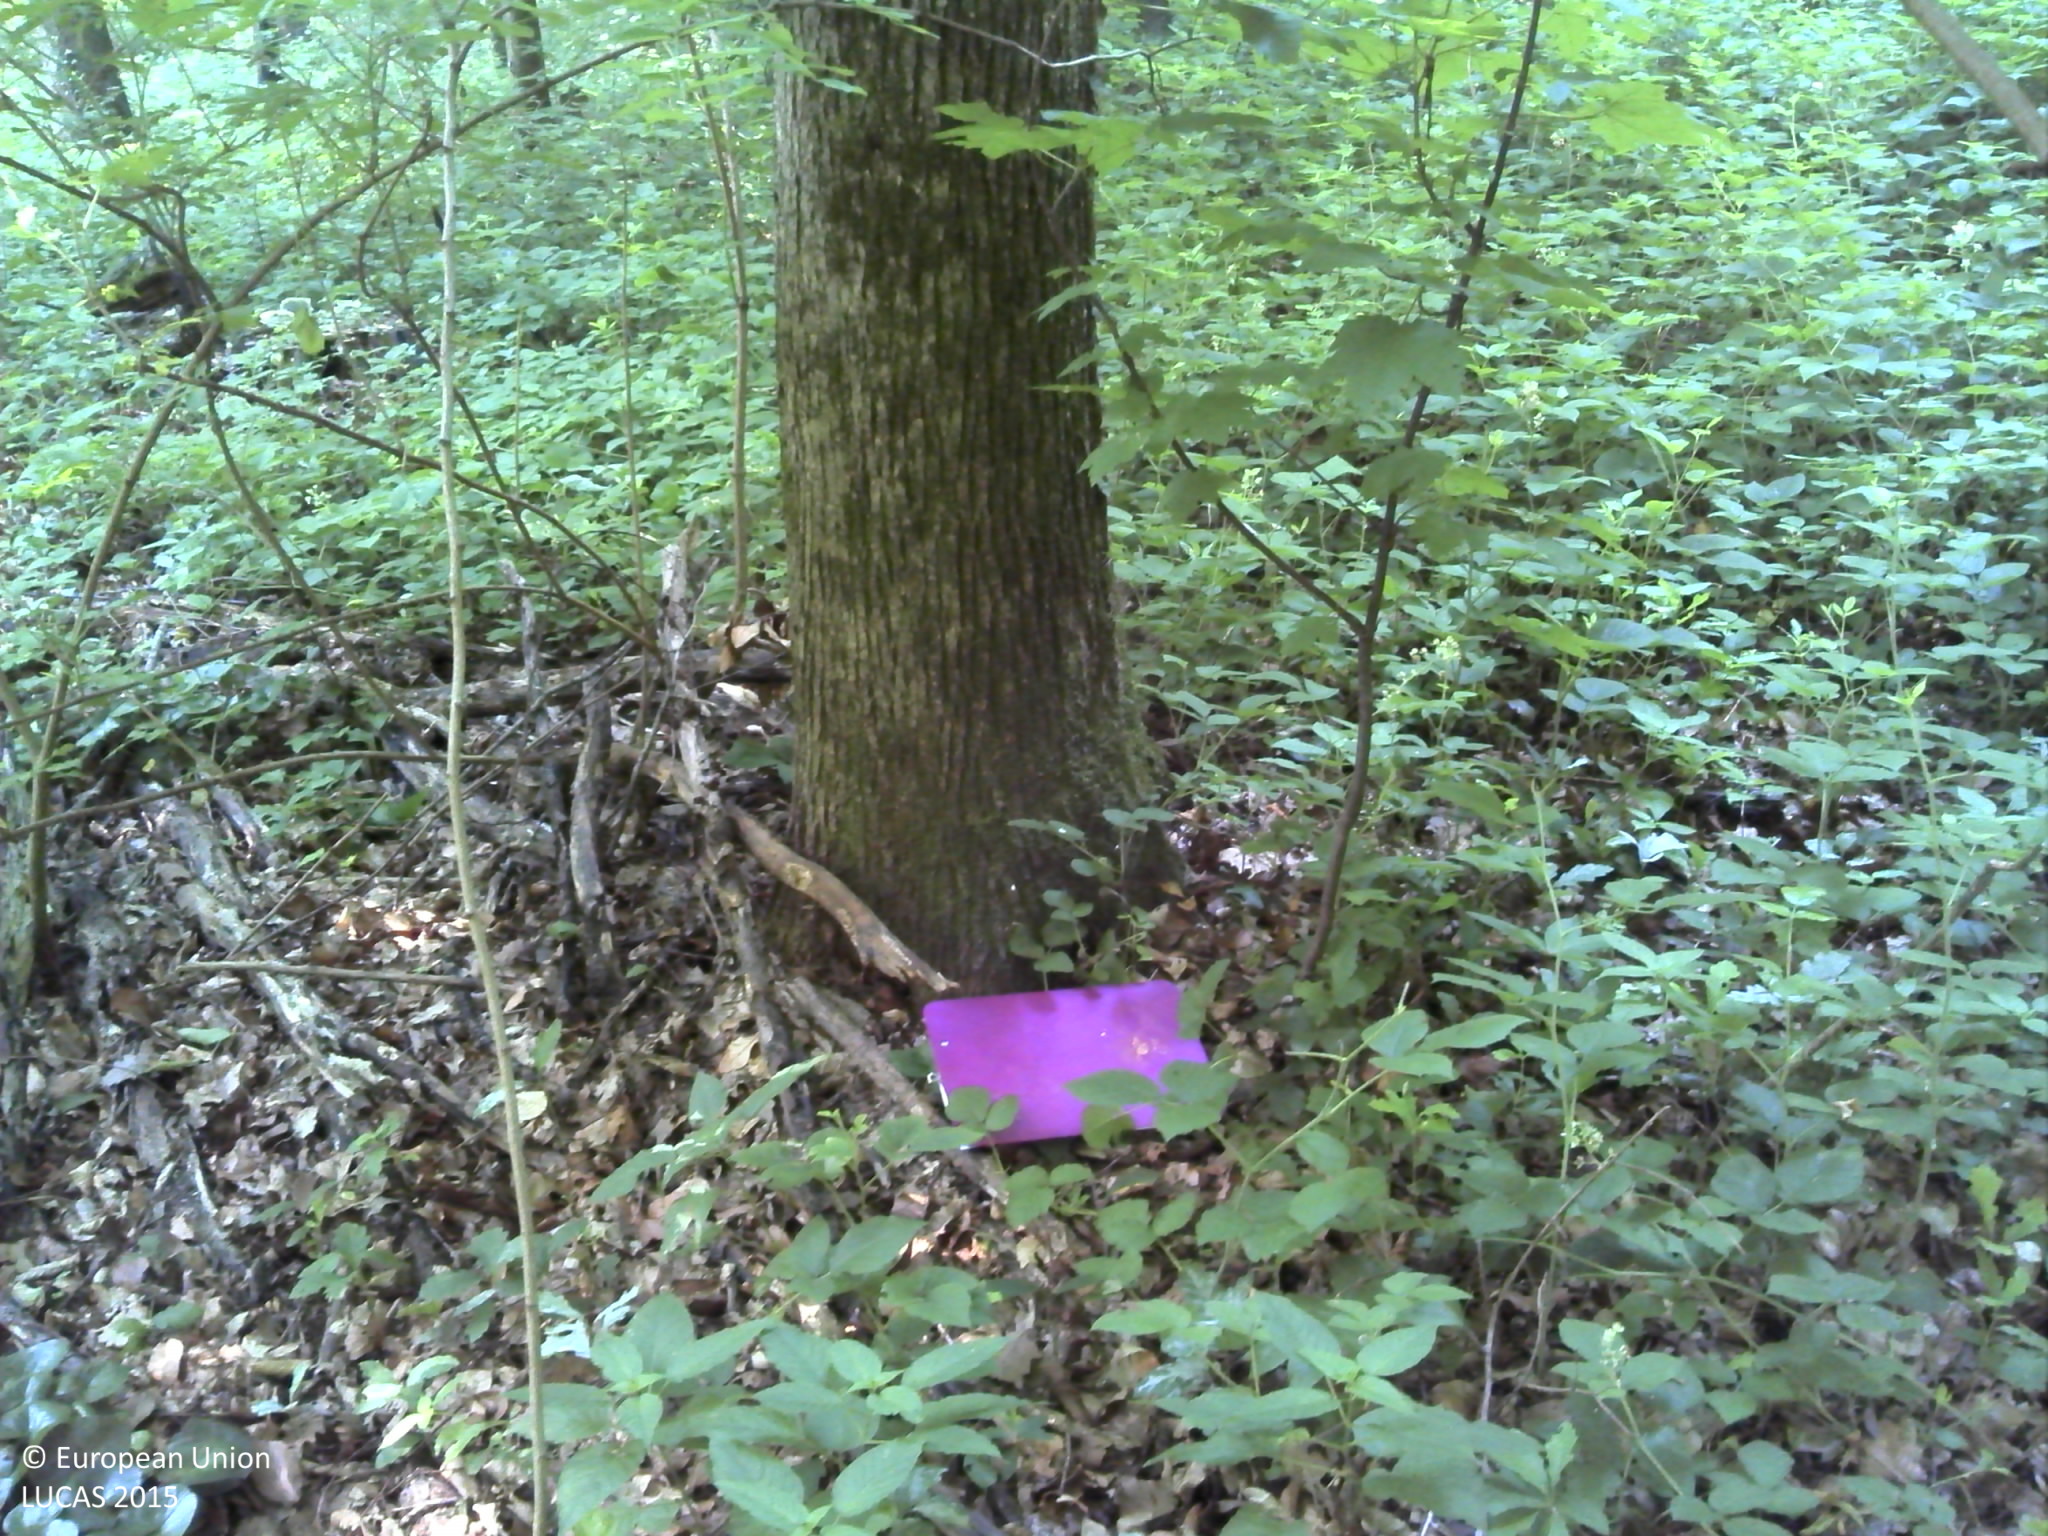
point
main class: Woodland
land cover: Broadleaved woodland
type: beech forest
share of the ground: > 75 %
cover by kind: broadleaved forest trees 90 %, shrubs 5 %, lichens and mosses 5 %
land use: Forestry
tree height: > 5 m
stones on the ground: < 10 %
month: June
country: HR
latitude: 45.2418
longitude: 18.1696
